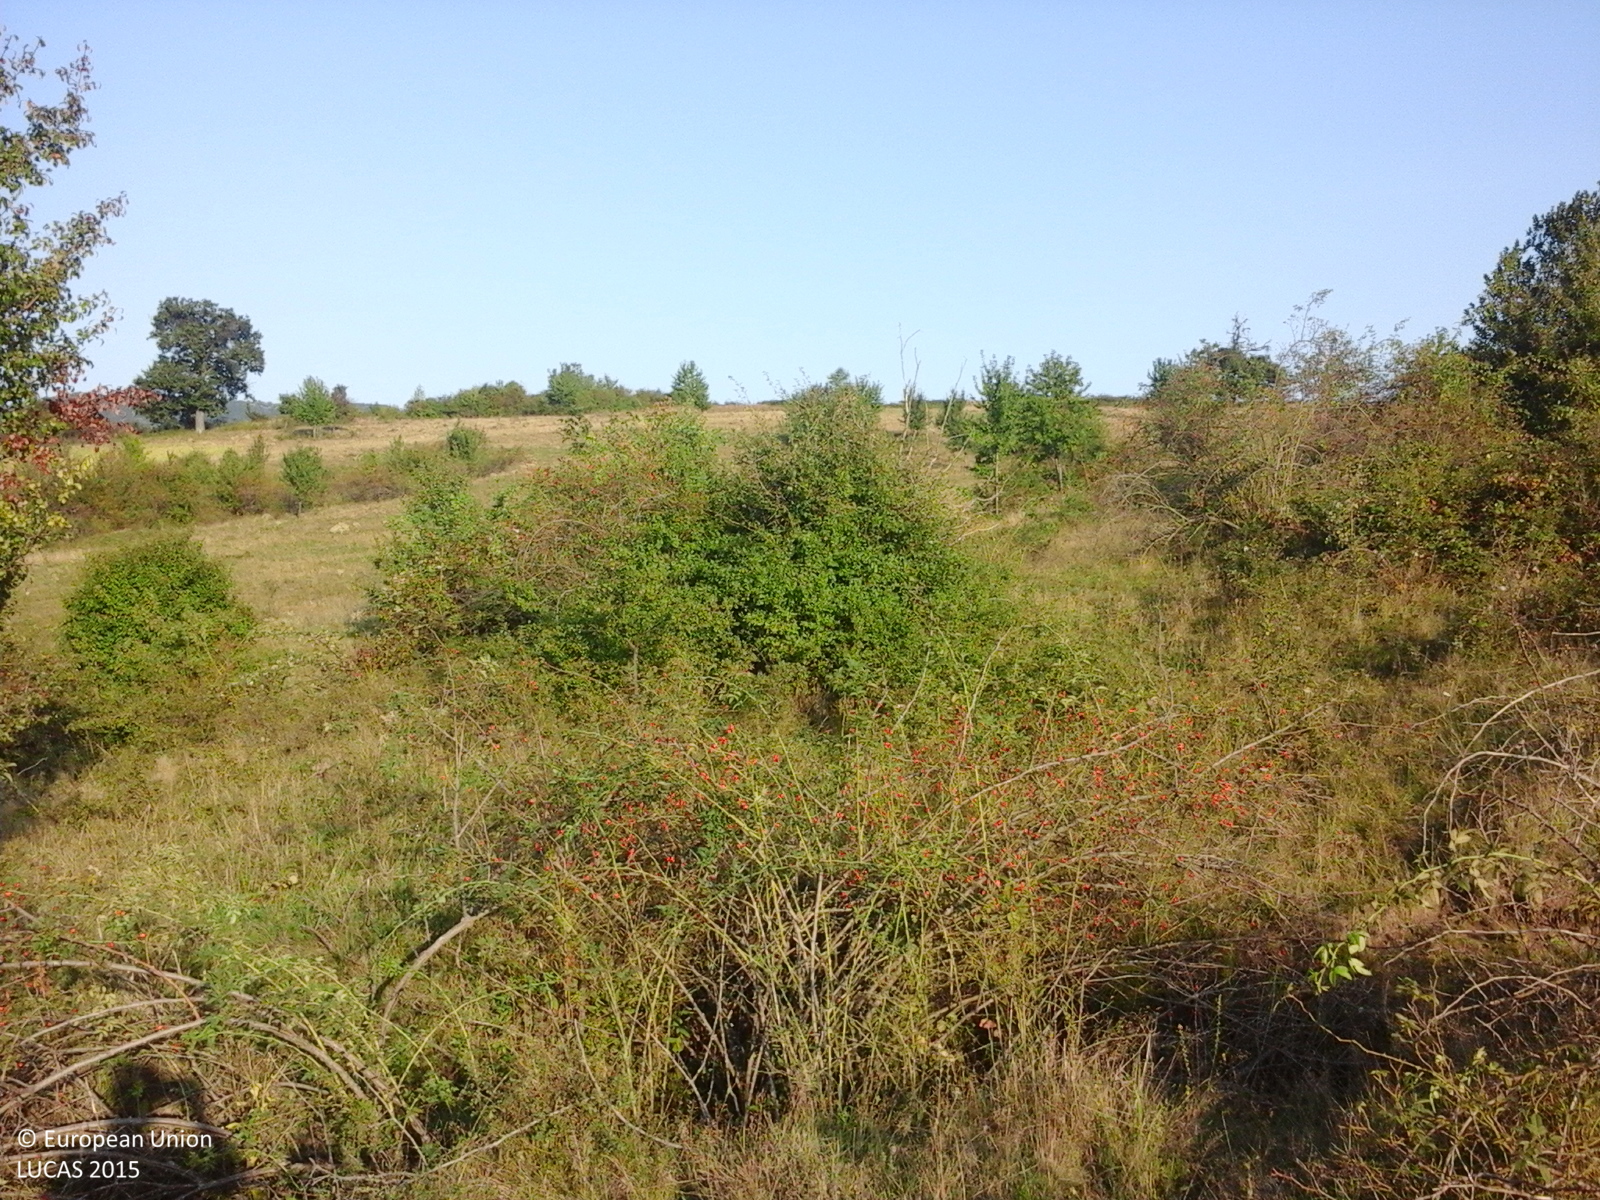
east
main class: Grassland
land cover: Grassland with sparse tree/shrub cover
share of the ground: > 75 %
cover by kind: herbaceous plants 90 %, broadleaved forest trees 5 %, shrubs 5 %
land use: Agriculture (excluding fallow land and kitchen gardens)
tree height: < 5 m
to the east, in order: Grassland with sparse tree/shrub cover; Shrubland without tree cover; Grassland with sparse tree/shrub cover; Shrubland without tree cover; Grassland with sparse tree/shrub cover
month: September
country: RO
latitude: 47.2422
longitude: 22.7552
